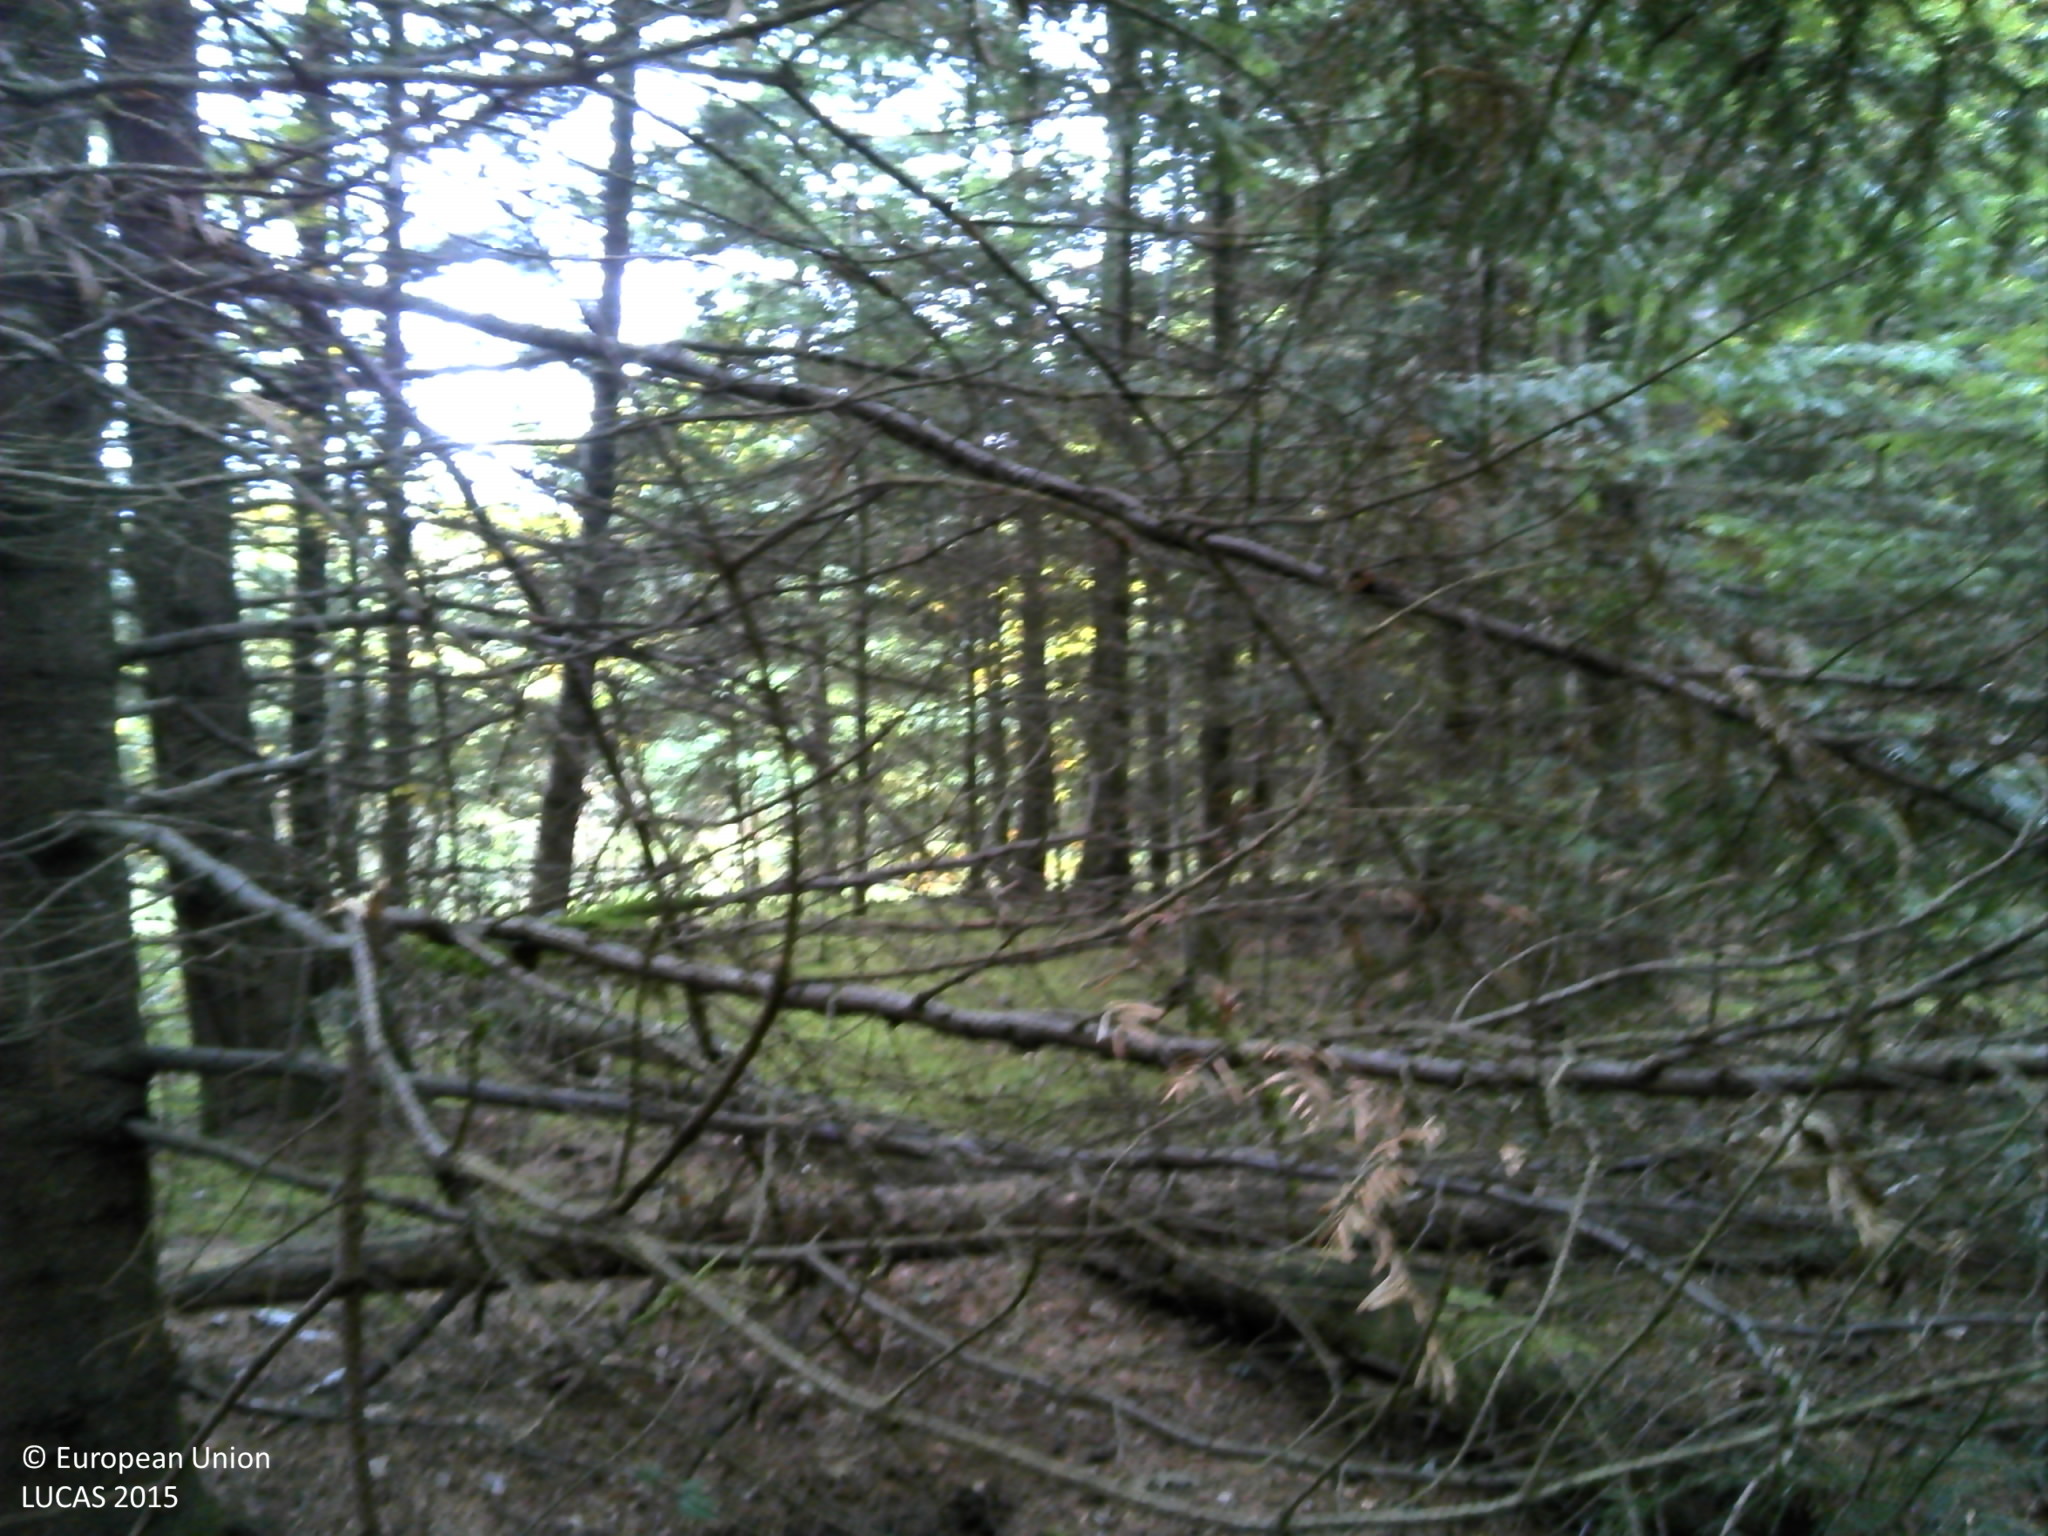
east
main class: Woodland
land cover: Other mixed woodland
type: mesophytic deciduous forest
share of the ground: > 75 %
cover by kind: coniferous forest trees 50 %, broadleaved forest trees 20 %, lichens and mosses 20 %, unconsolidated bare surface 10 %
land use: Forestry
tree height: > 5 m
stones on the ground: < 10 %
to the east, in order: Other mixed woodland; Tracks; Grassland with sparse tree/shrub cover; Spruce dominated coniferous woodland; Shrubland without tree cover; Spruce dominated coniferous woodland
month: October
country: FR
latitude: 45.4831
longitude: 3.7719
